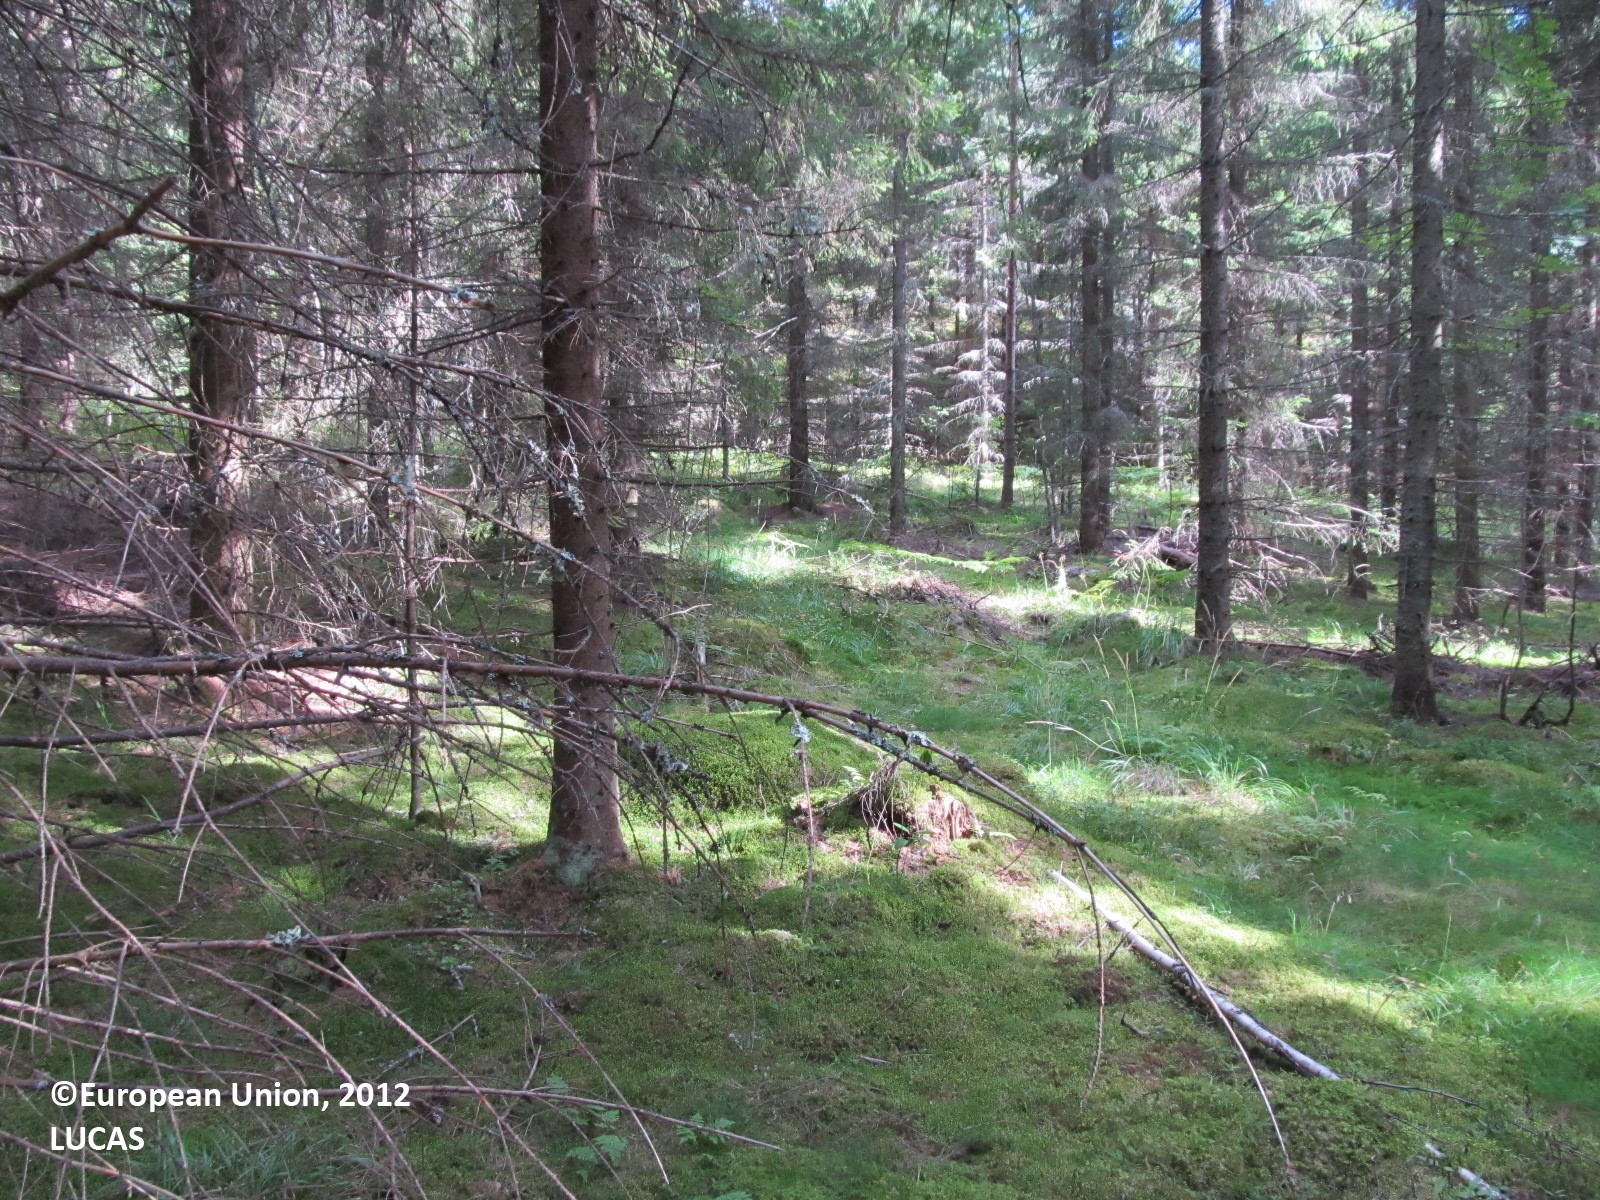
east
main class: Woodland
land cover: Spruce dominated coniferous woodland
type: boreal forest
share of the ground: 50 - 75 %
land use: Forestry
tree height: > 5 m
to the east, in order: Spruce dominated coniferous woodland; Tracks; Pine dominated mixed woodland; Broadleaved woodland
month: August
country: FI
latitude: 61.6625
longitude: 27.6888
